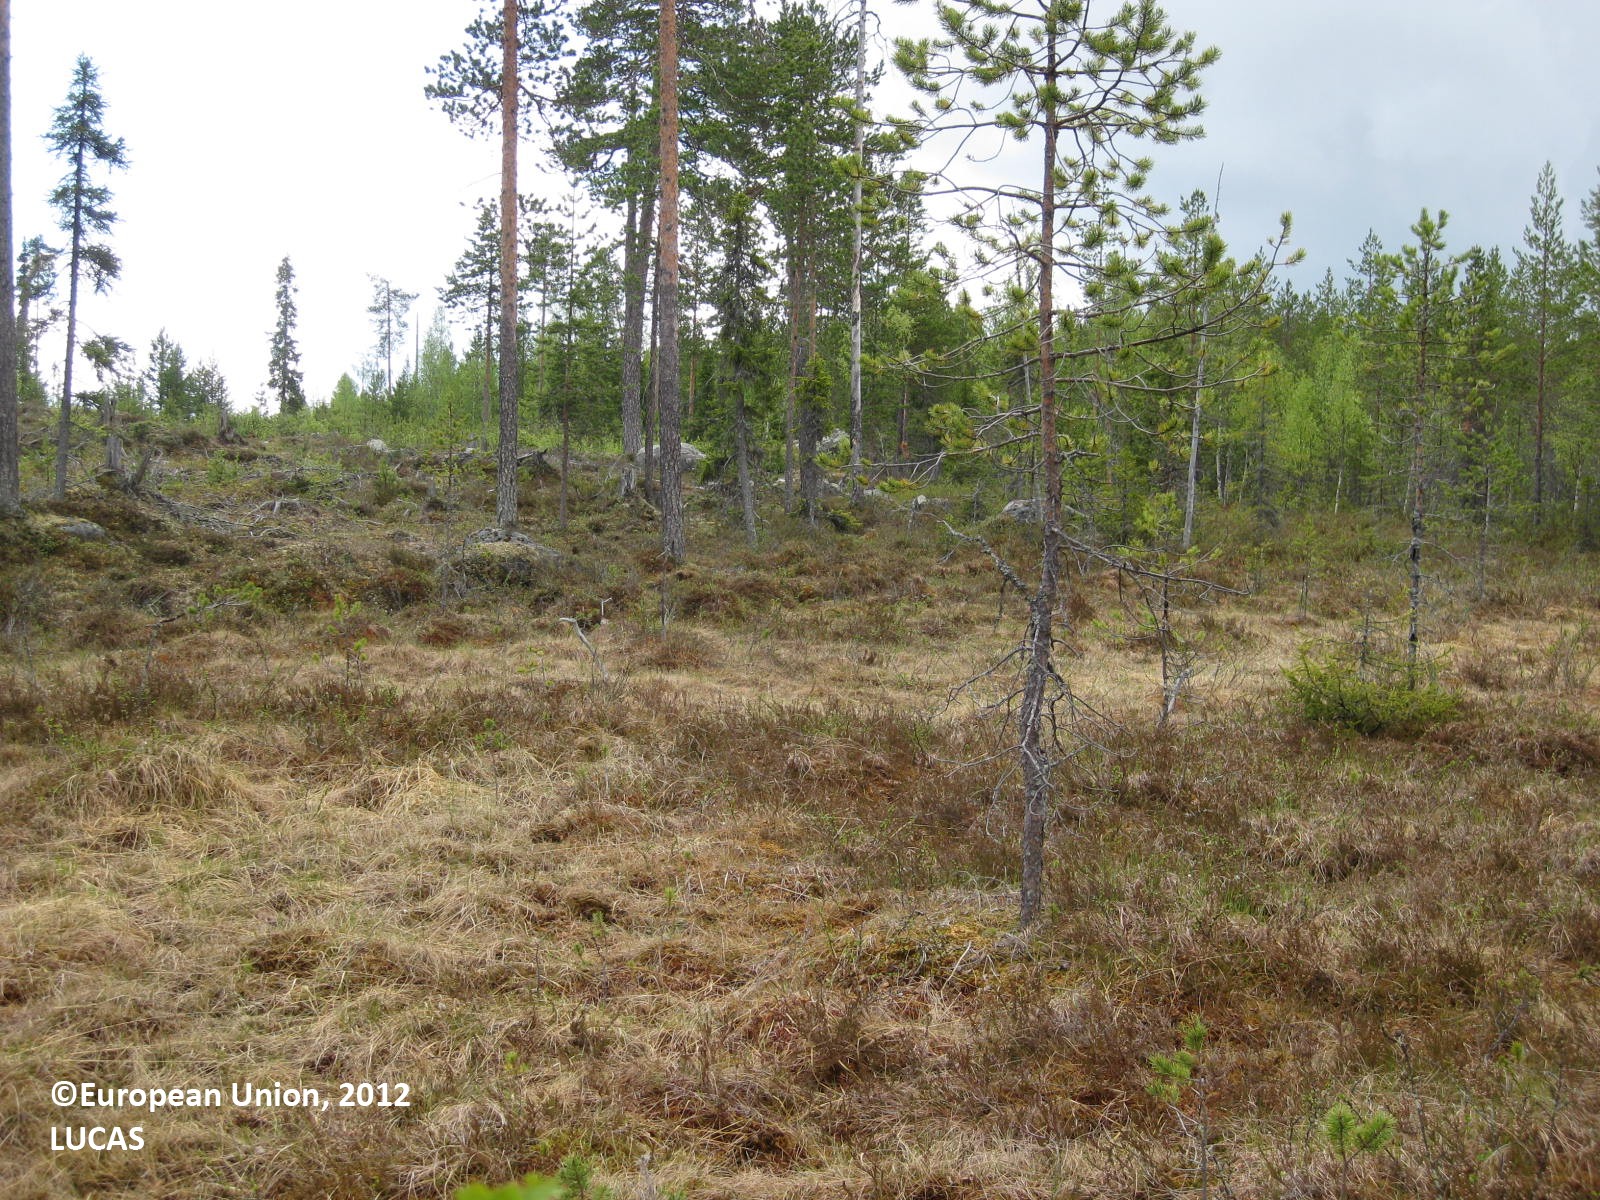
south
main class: Woodland
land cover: Pine dominated mixed woodland
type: boreal forest
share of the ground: 25 - 50 %
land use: Forestry
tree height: > 5 m
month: June
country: FI
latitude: 65.2089
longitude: 29.6815
